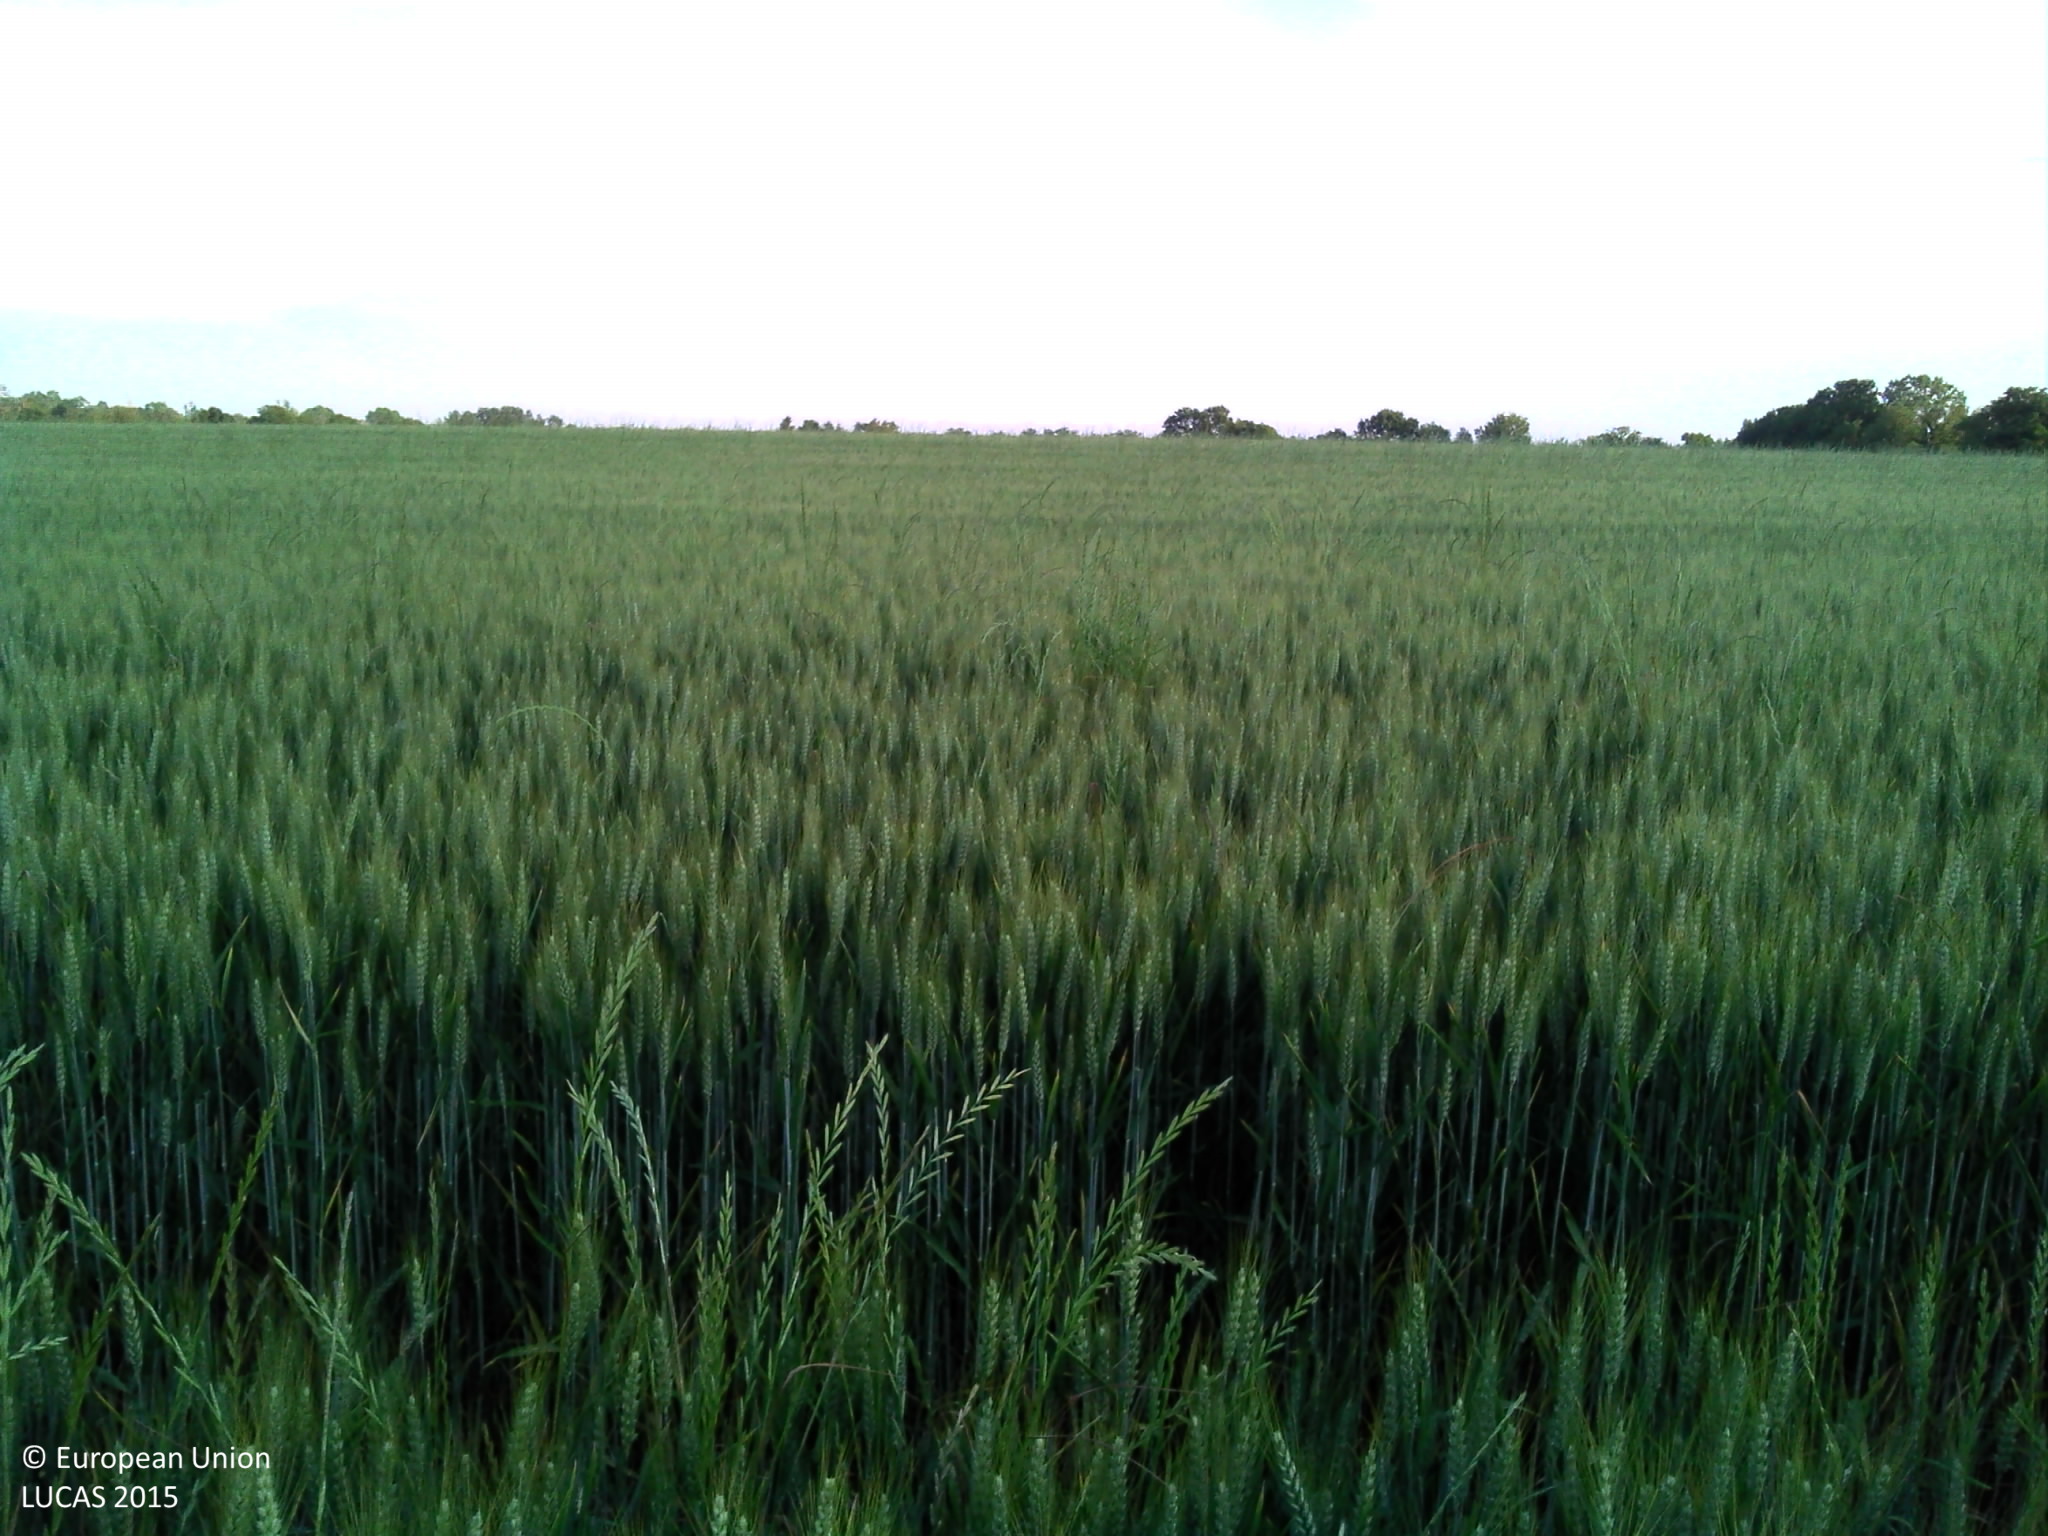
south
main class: Cropland
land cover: Common wheat
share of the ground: > 75 %
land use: Agriculture (excluding fallow land and kitchen gardens)
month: June
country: FR
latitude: 46.8580
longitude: 2.9260
